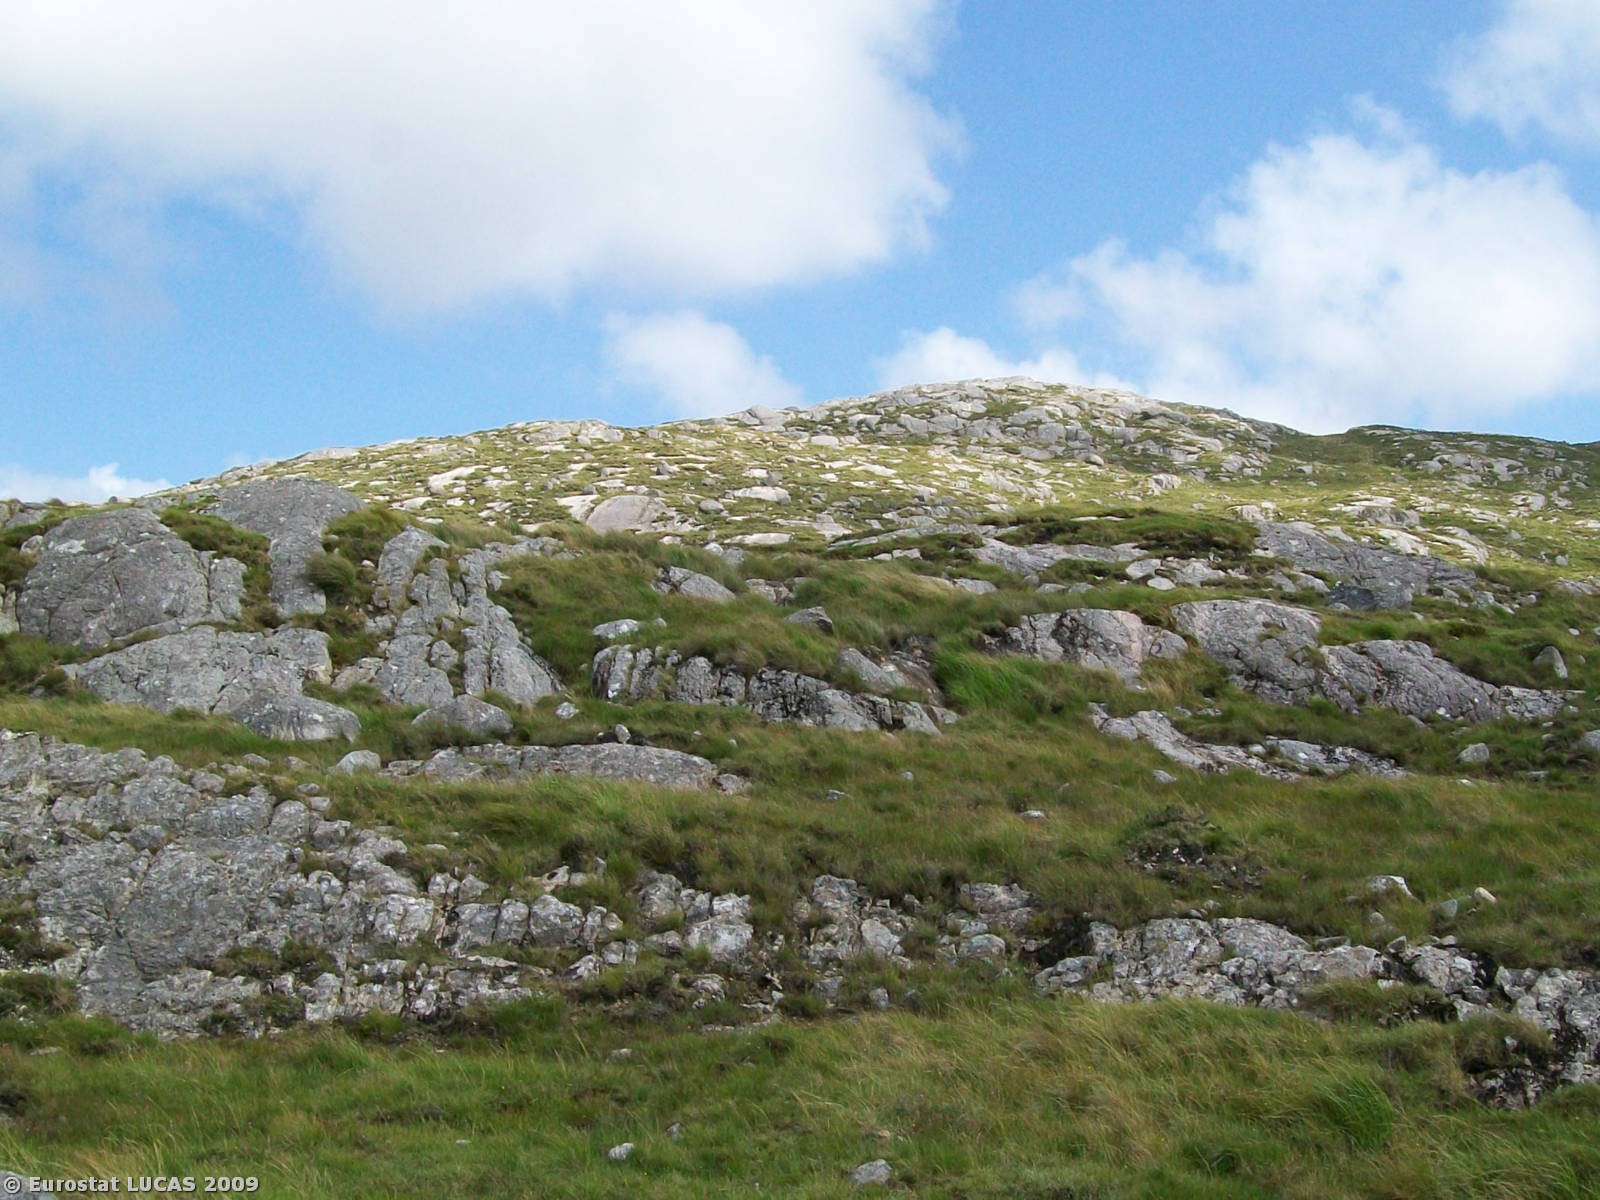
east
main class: Grassland
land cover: Grassland without tree/shrub cover
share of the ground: > 75 %
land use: Nature reserves
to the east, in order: Grassland without tree/shrub cover
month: August
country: IE
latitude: 53.3884
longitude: -9.4935
